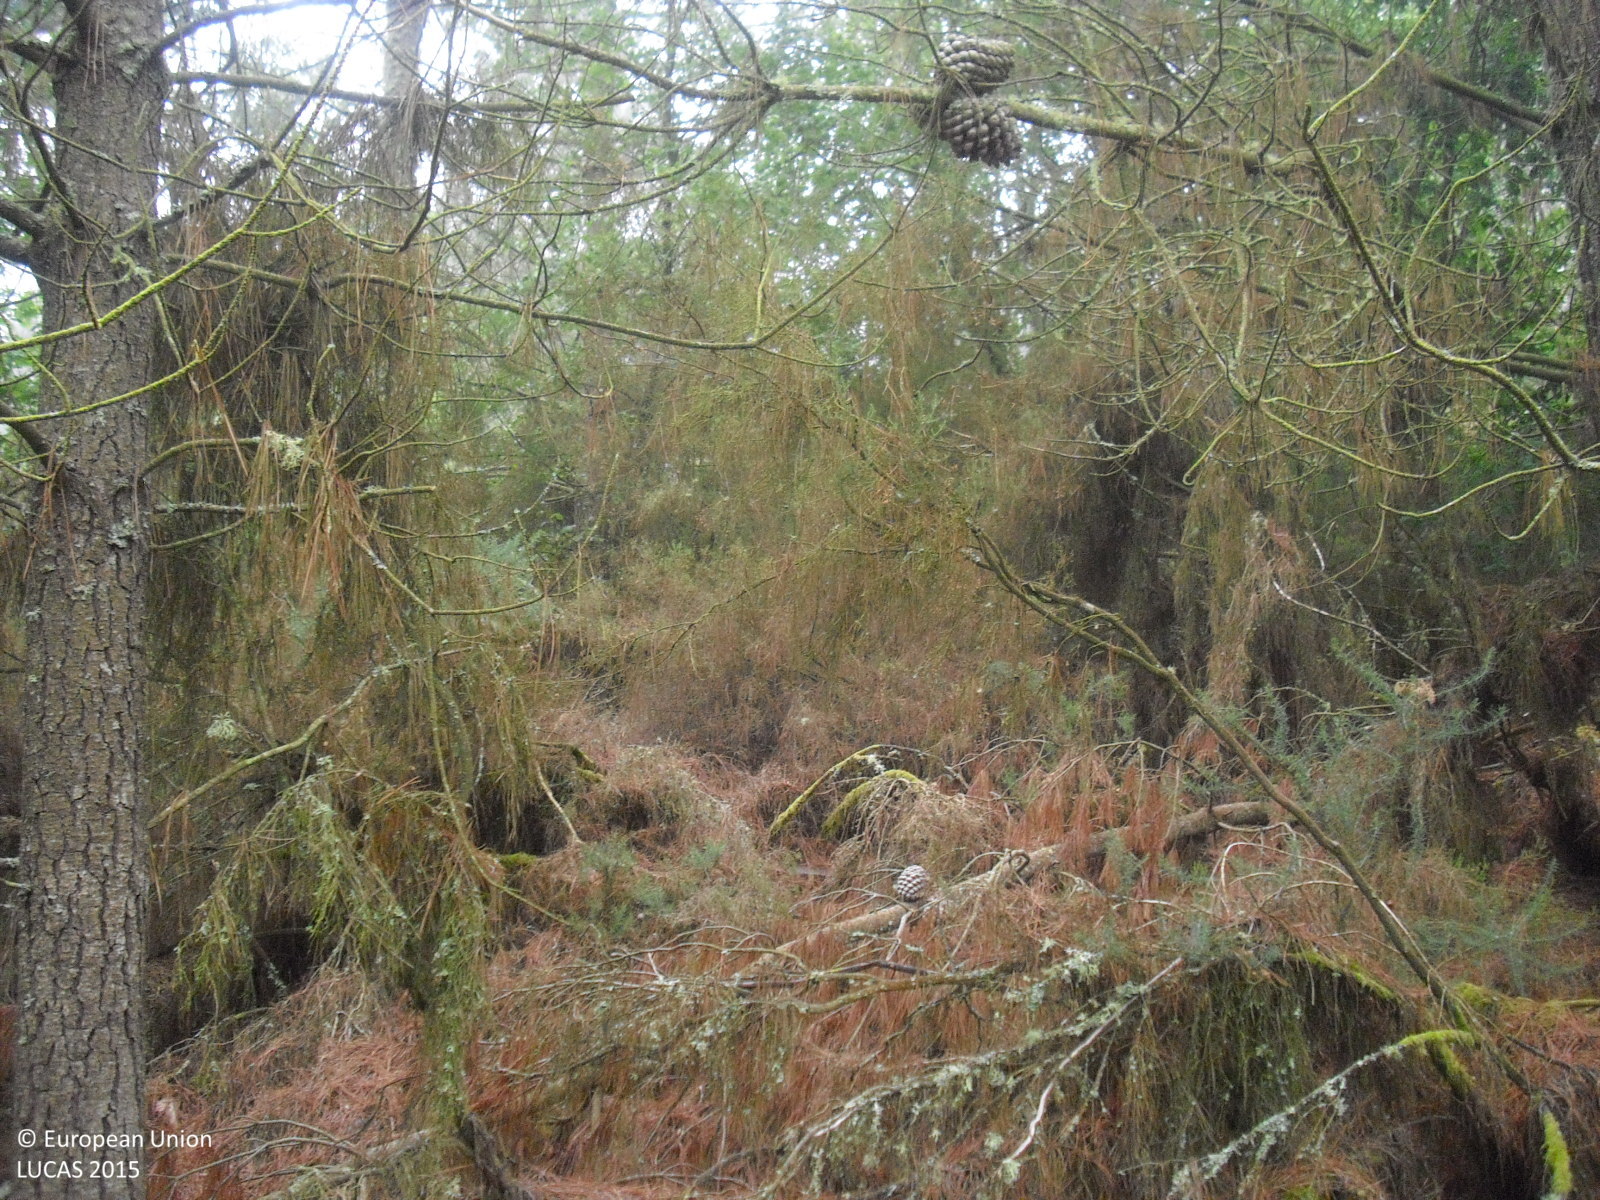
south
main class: Woodland
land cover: Pine dominated mixed woodland
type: hemiboreal forest and nemoral coniferous forest and mixed broadleaved-coniferous forest
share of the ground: 50 - 75 %
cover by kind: coniferous forest trees 40 %, broadleaved forest trees 30 %, shrubs 30 %
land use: Forestry
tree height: > 5 m
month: June
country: ES
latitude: 42.6795
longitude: -7.9375
